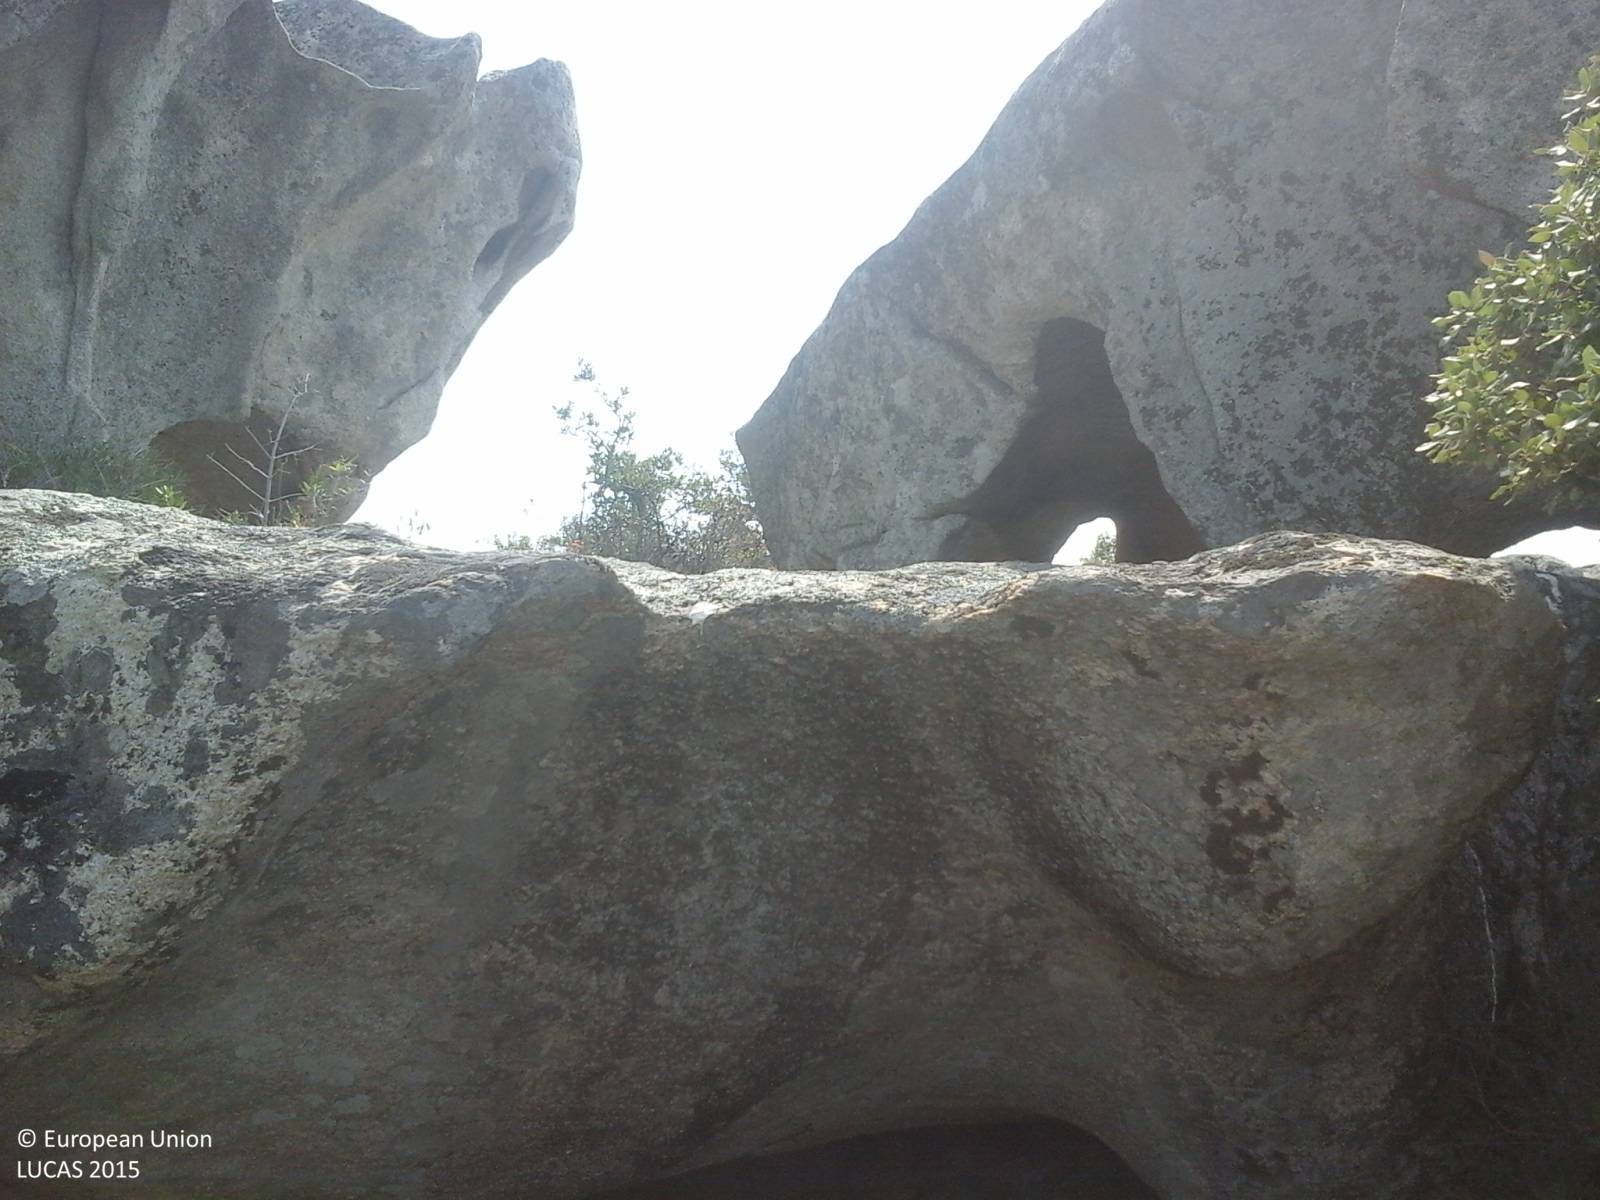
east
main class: Woodland
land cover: Broadleaved woodland
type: broadleaved evergreen forest
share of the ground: > 75 %
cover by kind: broadleaved forest trees 95 %, consolidated bare surface 5 %
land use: Semi-natural and natural areas not in use
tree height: > 5 m
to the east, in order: Broadleaved woodland; Rocks and stones; Shrubland with sparse tree cover; Grassland without tree/shrub cover; Fences; Electric lines; Grass margins; Paved roads, cycling and walking lanes; Grass margins; Fences; Electric lines; Grassland without tree/shrub cover; Shrubland without tree cover
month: July
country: IT
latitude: 40.8990
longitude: 9.4211
